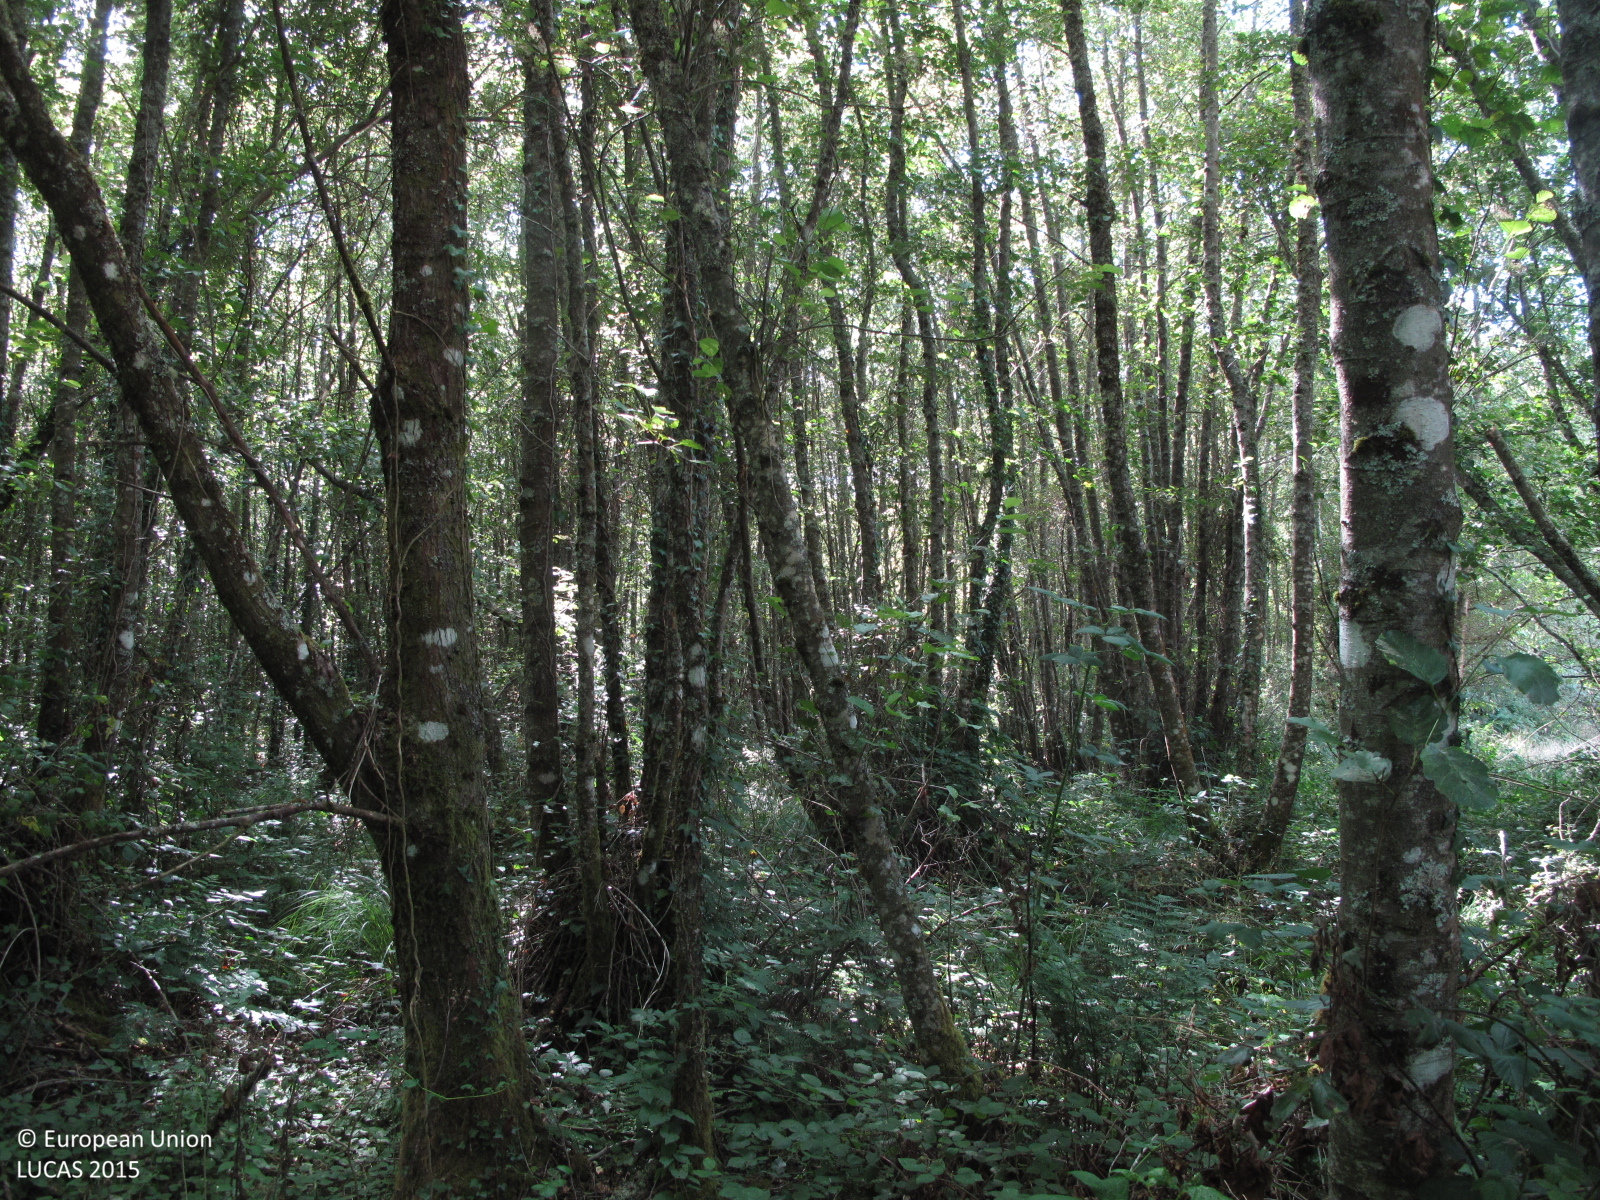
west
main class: Woodland
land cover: Broadleaved woodland
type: floodplain forest
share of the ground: > 75 %
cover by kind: broadleaved forest trees 90 %, shrubs 5 %, herbaceous plants 5 %
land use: Semi-natural and natural areas not in use
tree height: > 5 m
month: July
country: ES
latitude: 43.0592
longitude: -7.9798
